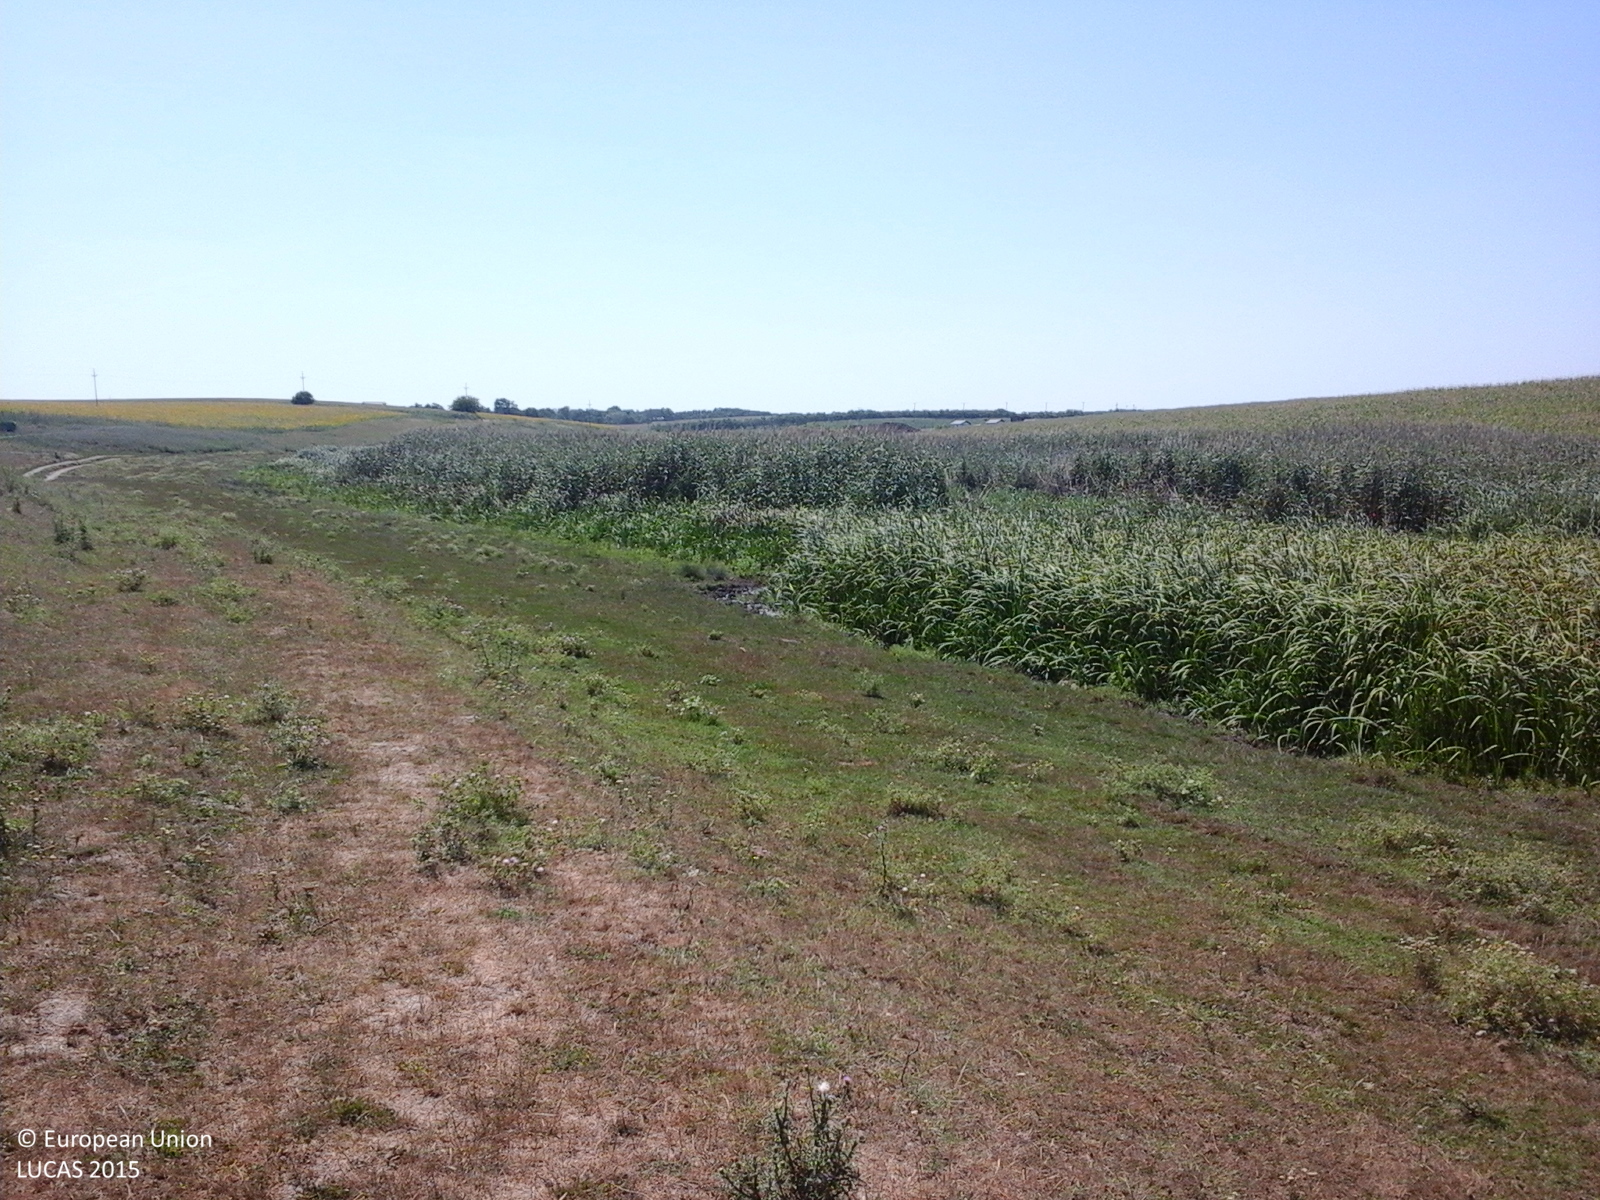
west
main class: Grassland
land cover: Grassland without tree/shrub cover
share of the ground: > 75 %
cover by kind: herbaceous plants 100 %
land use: Agriculture (excluding fallow land and kitchen gardens)
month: July
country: RO
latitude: 44.3853
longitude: 26.5725
